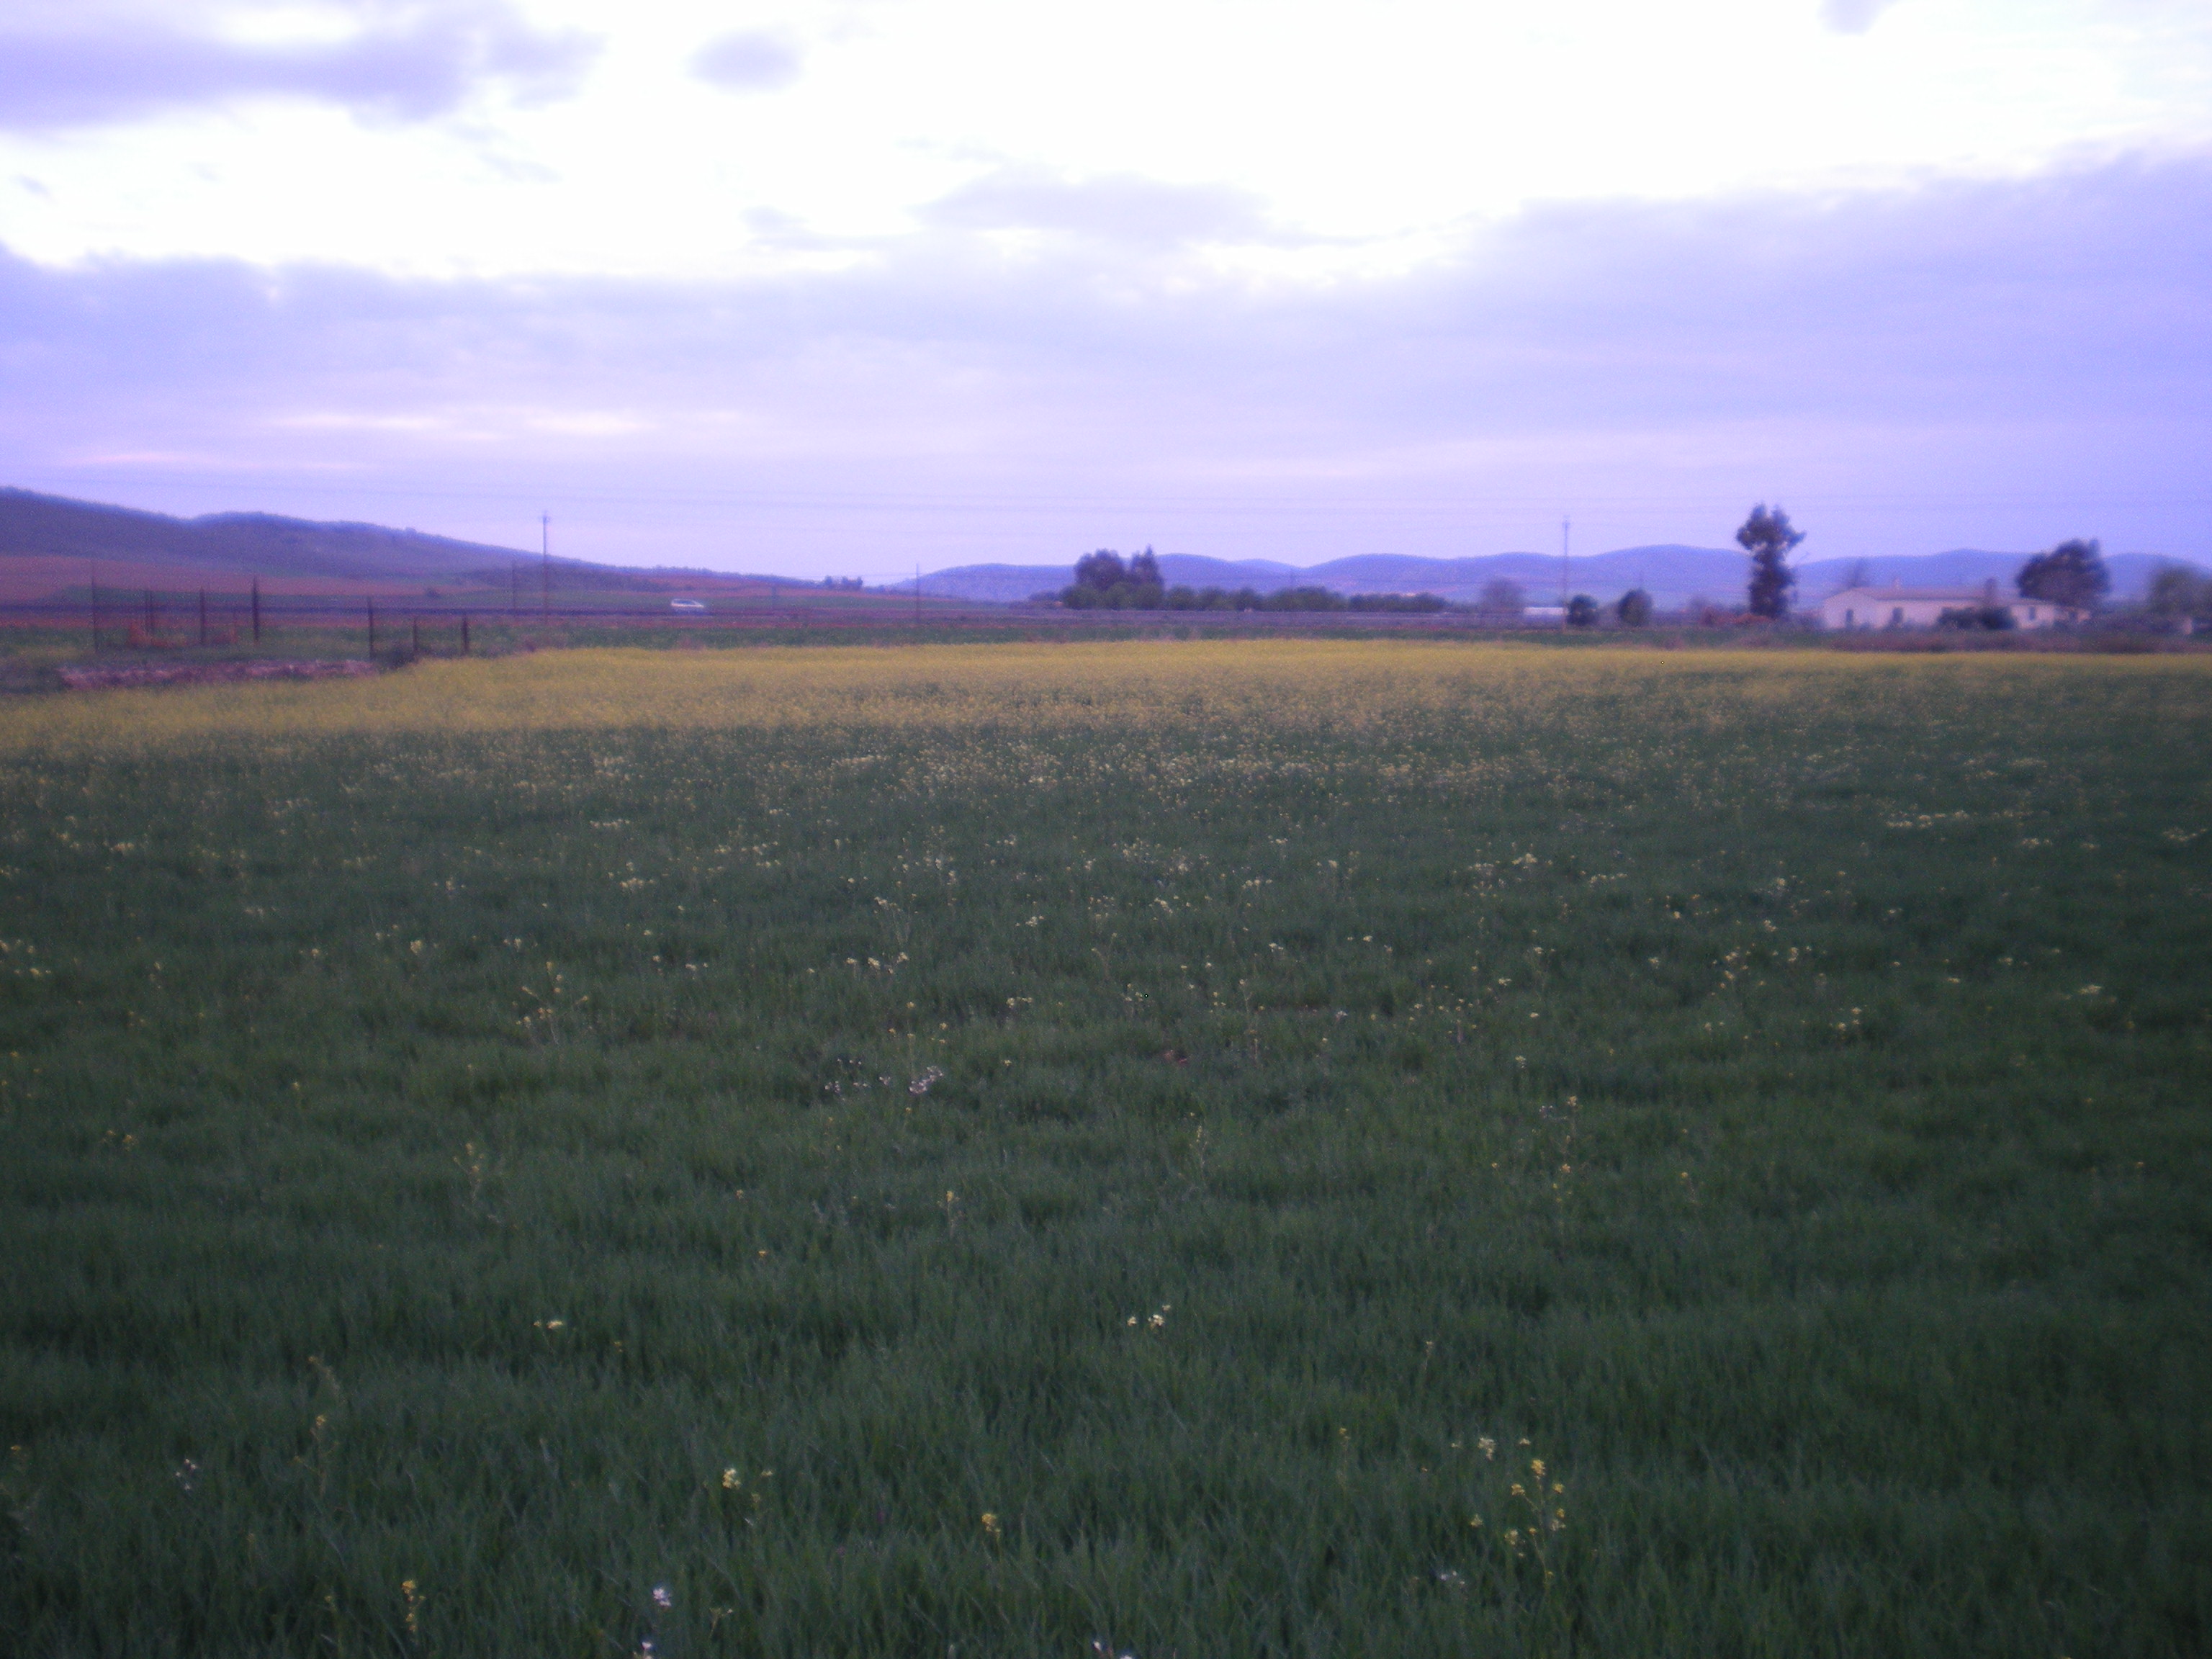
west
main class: Cropland
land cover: Oats
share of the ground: > 75 %
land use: Agriculture (excluding fallow land and kitchen gardens)
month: April
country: ES
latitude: 38.6206
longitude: -3.4594
